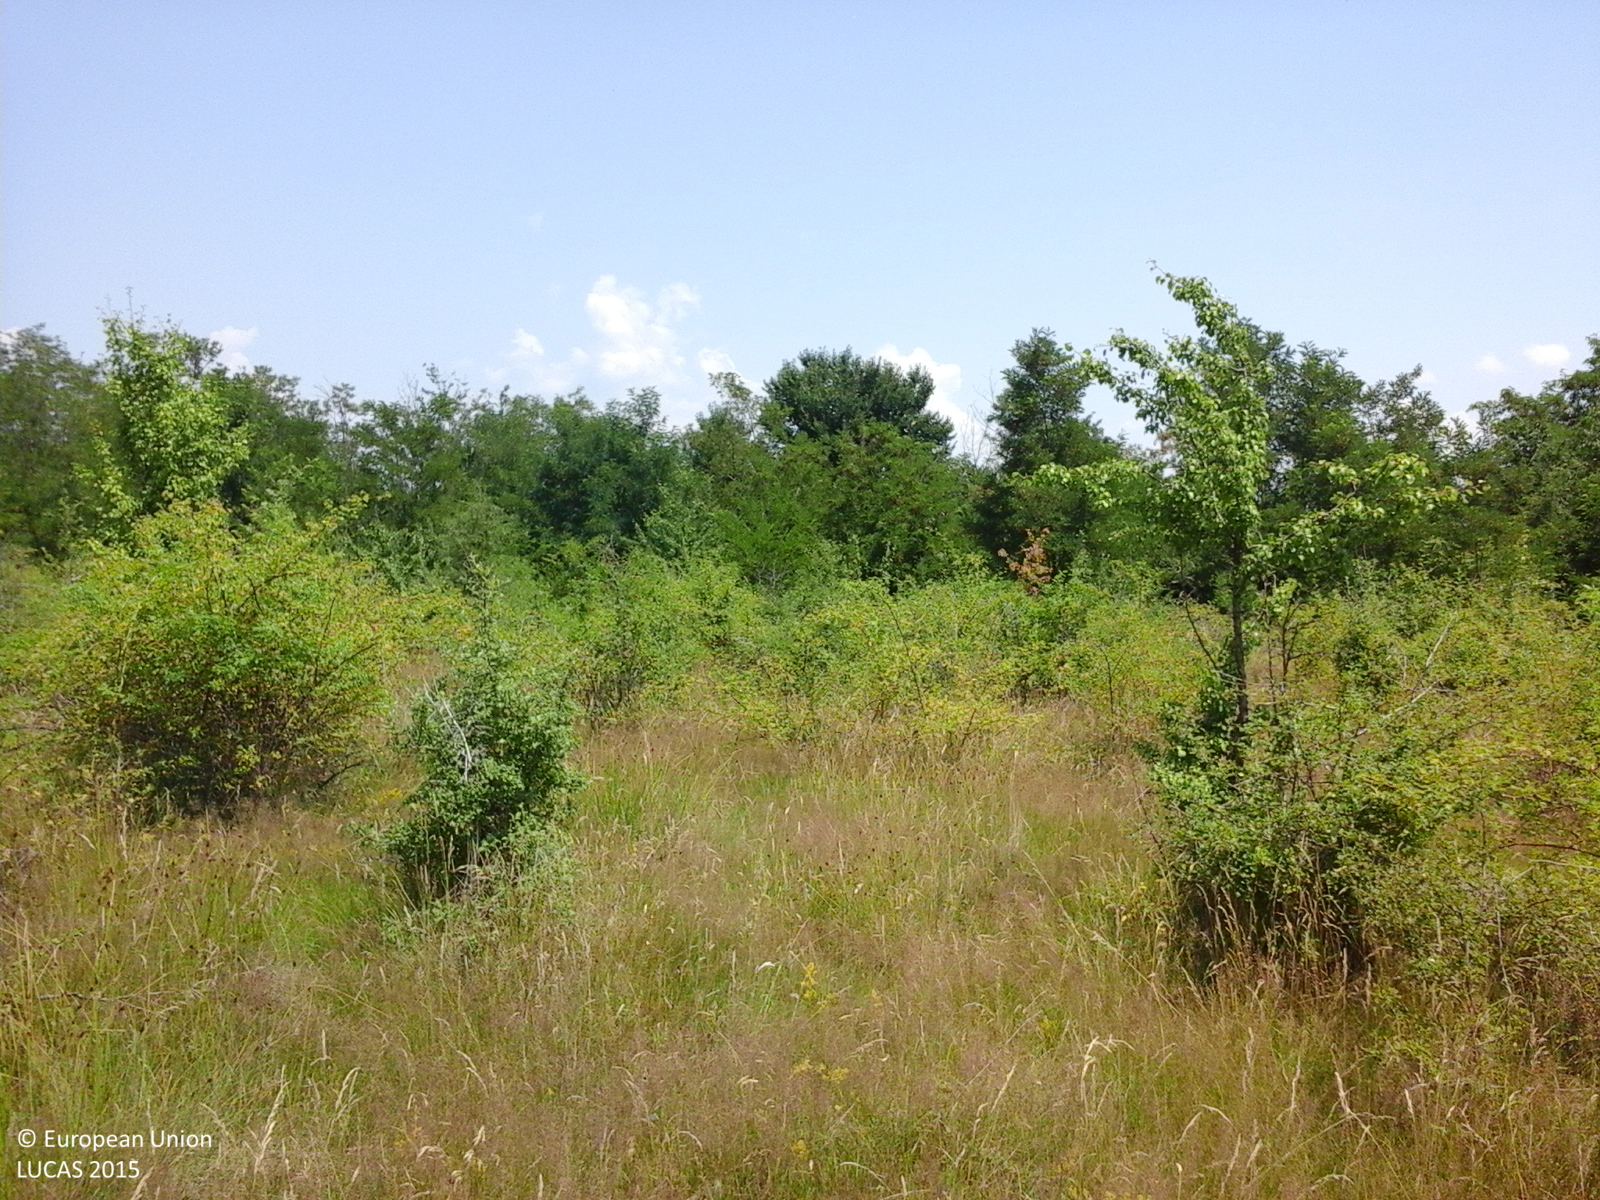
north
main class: Shrubland
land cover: Shrubland with sparse tree cover
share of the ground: > 75 %
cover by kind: shrubs 80 %, herbaceous plants 15 %, broadleaved forest trees 5 %
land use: Semi-natural and natural areas not in use
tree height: < 5 m
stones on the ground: < 10 %
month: July
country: RO
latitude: 45.0197
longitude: 24.6857
